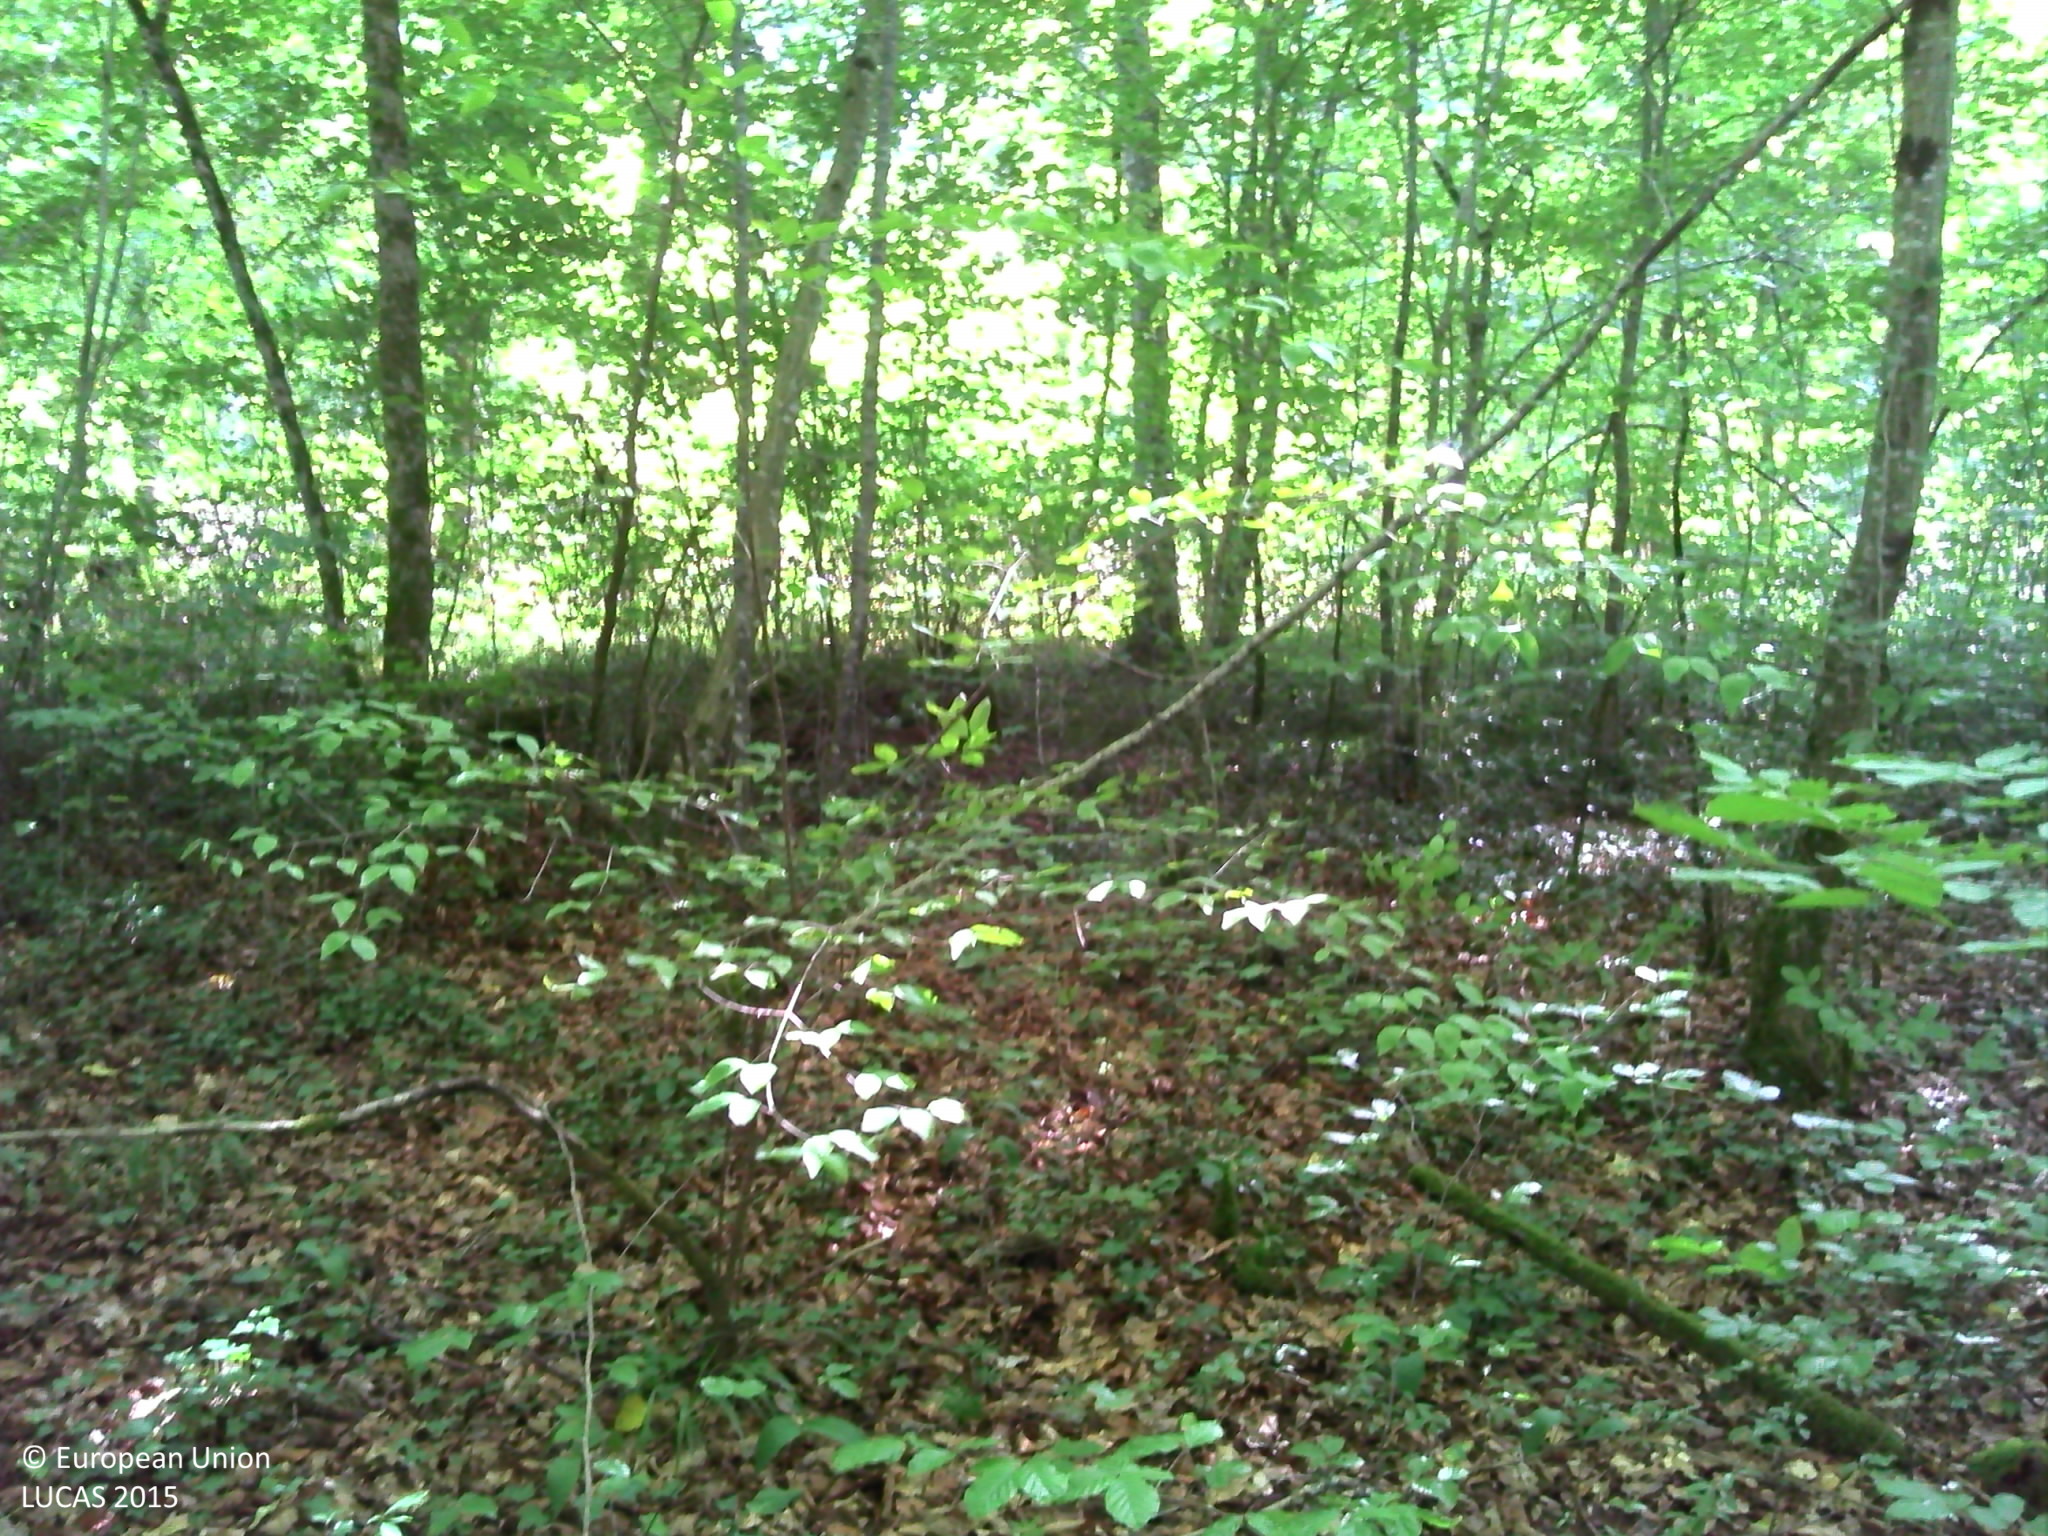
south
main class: Woodland
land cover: Broadleaved woodland
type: mesophytic deciduous forest
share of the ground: > 75 %
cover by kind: broadleaved forest trees 90 %, herbaceous plants 5 %, lichens and mosses 5 %
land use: Forestry
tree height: > 5 m
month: August
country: FR
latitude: 47.8343
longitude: 4.8824
